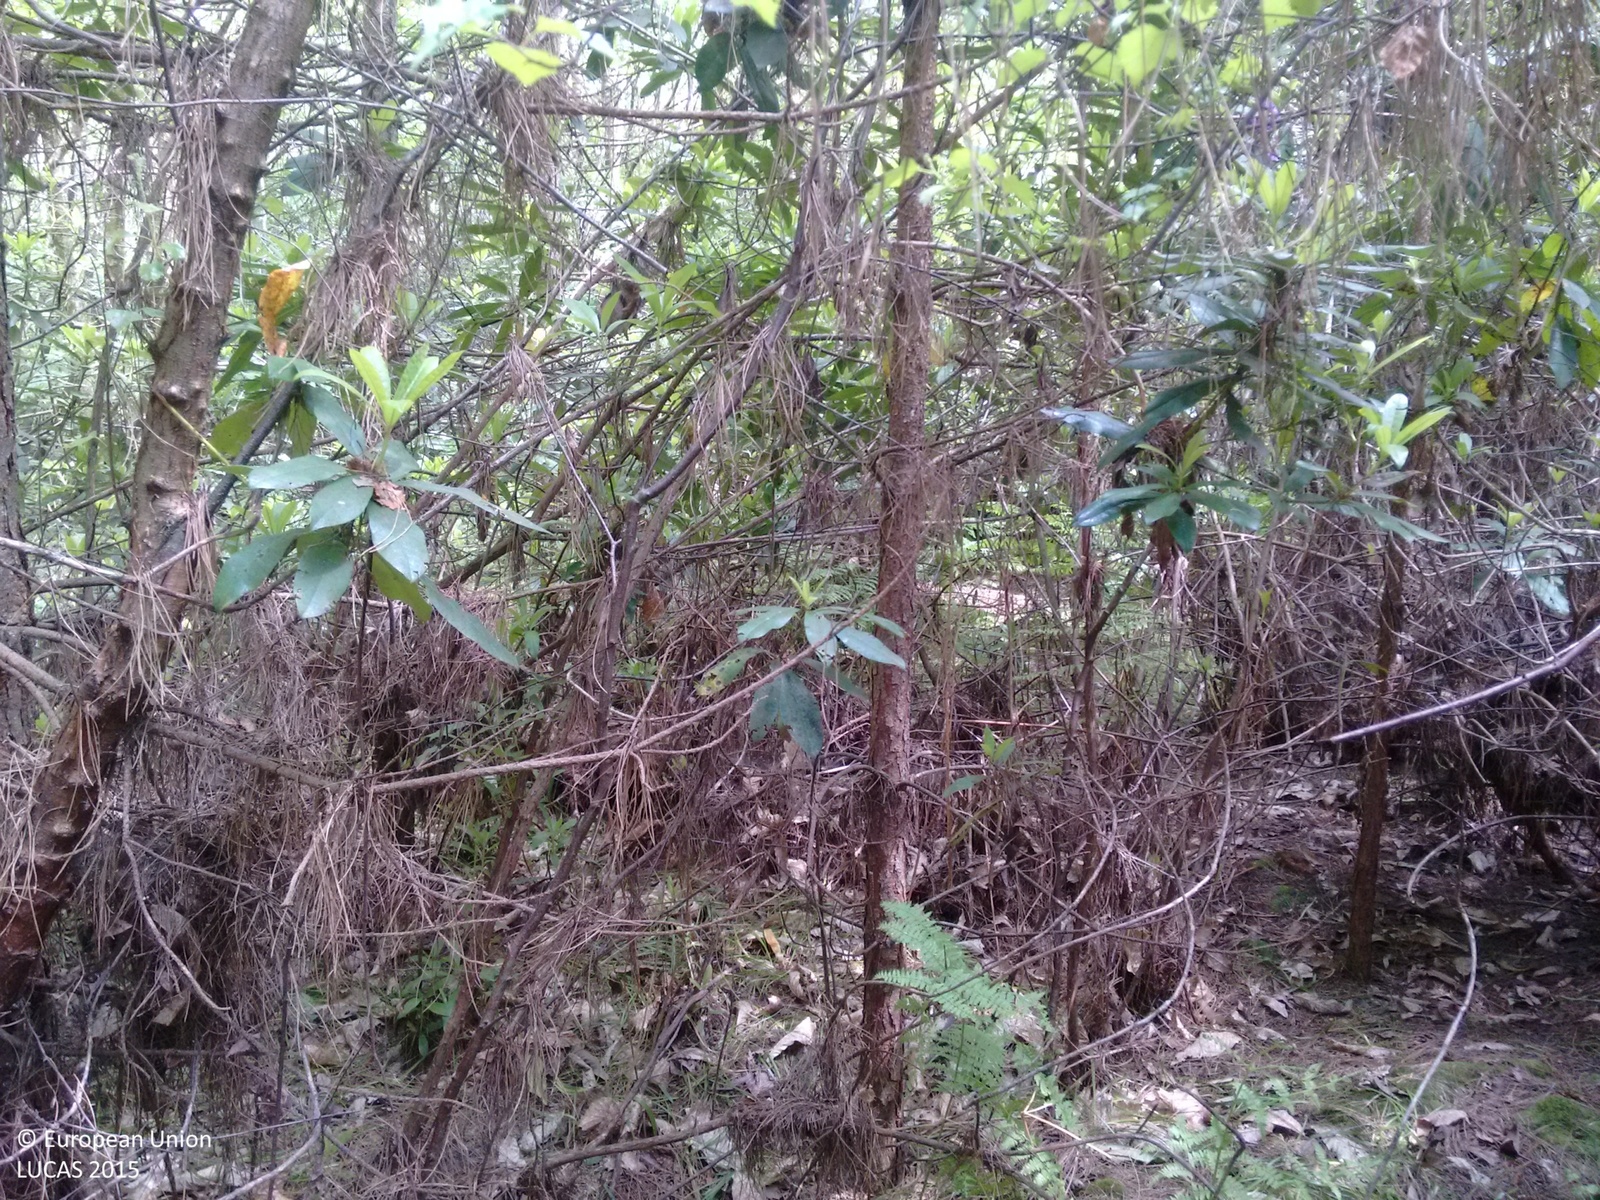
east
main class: Woodland
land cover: Pine dominated coniferous woodland
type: exotic forest
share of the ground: > 75 %
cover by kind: coniferous forest trees 95 %, shrubs 5 %
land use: Forestry
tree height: > 5 m
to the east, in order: Pine dominated coniferous woodland; Broadleaved woodland; Tracks; Other mixed woodland; Pine dominated coniferous woodland; Broadleaved woodland; Tracks; Spruce dominated coniferous woodland
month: June
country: GB
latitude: 51.0979
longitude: 0.5911
